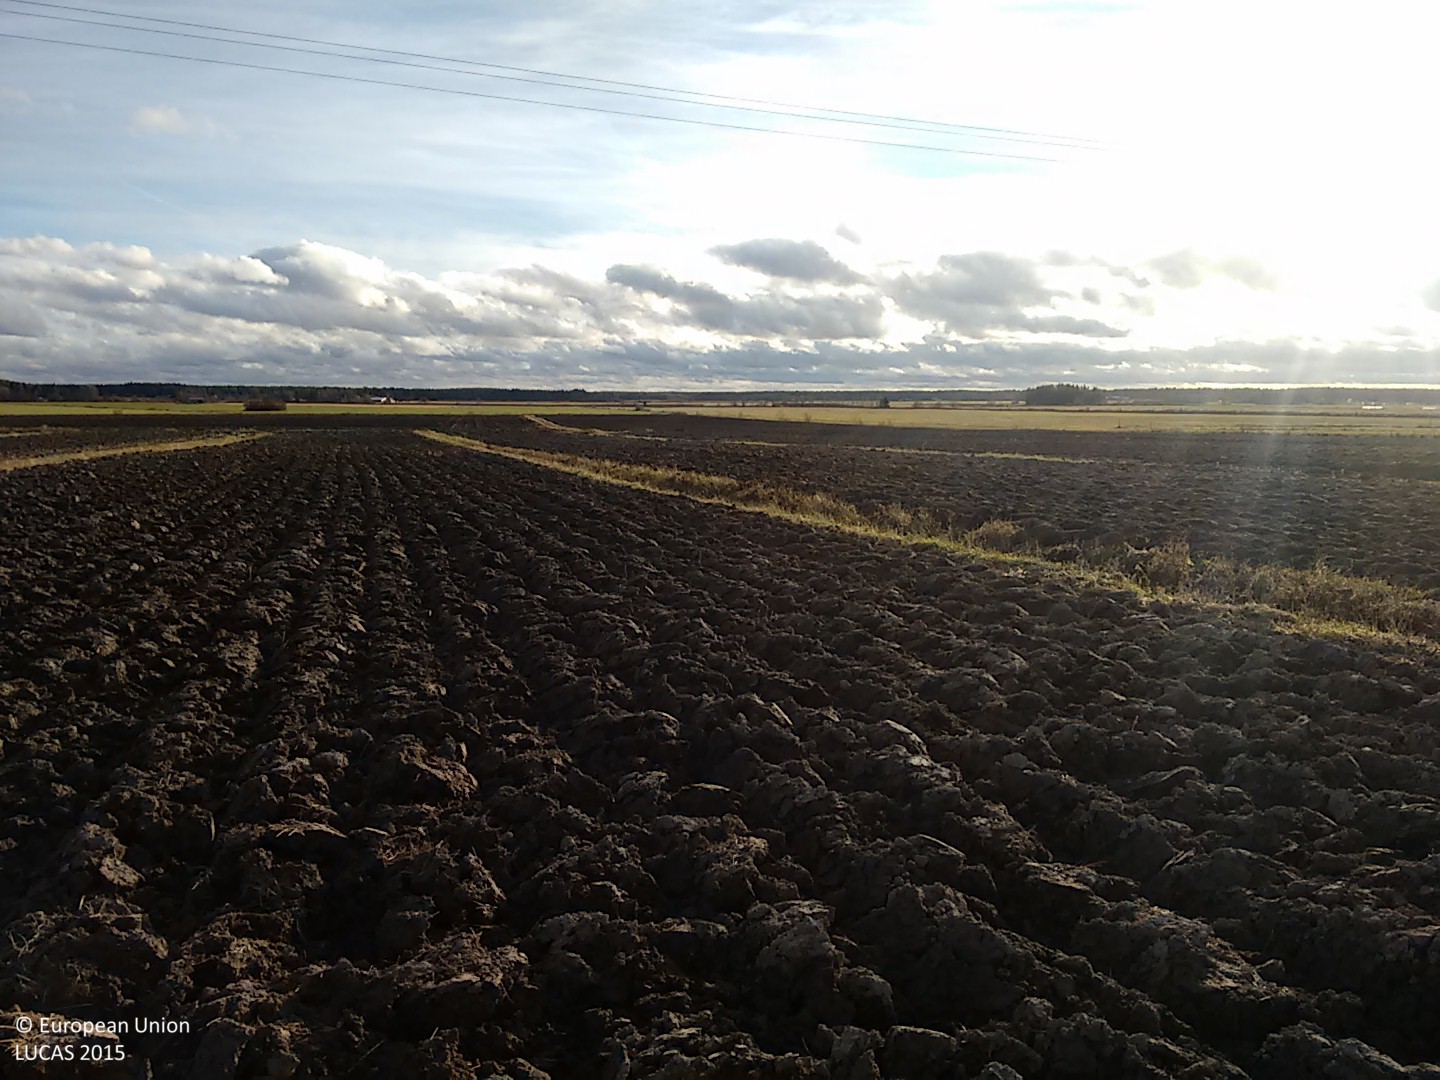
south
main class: Cropland
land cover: Barley
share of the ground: < 10 %
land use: Agriculture (excluding fallow land and kitchen gardens)
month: October
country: FI
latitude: 63.9615
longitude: 25.1360
